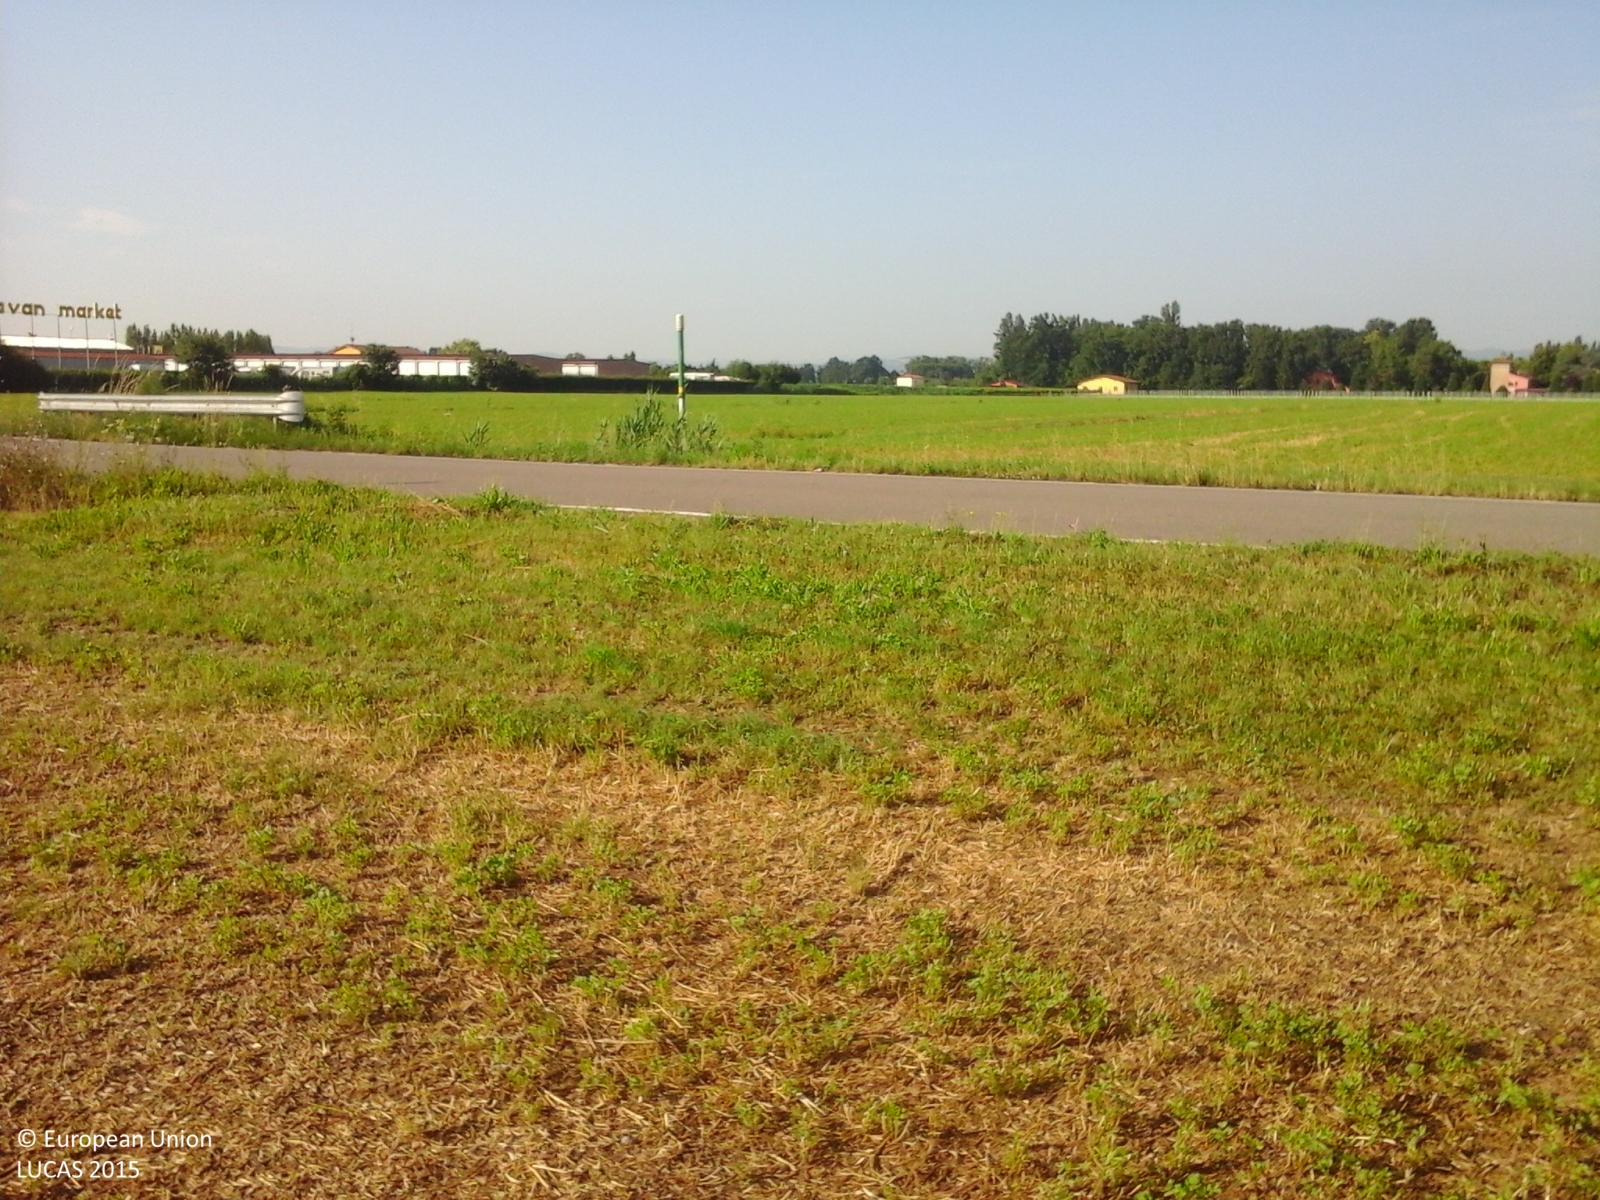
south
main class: Cropland
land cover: Lucerne
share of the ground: > 75 %
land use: Agriculture (excluding fallow land and kitchen gardens)
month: June
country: IT
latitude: 44.6168
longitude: 10.9431
